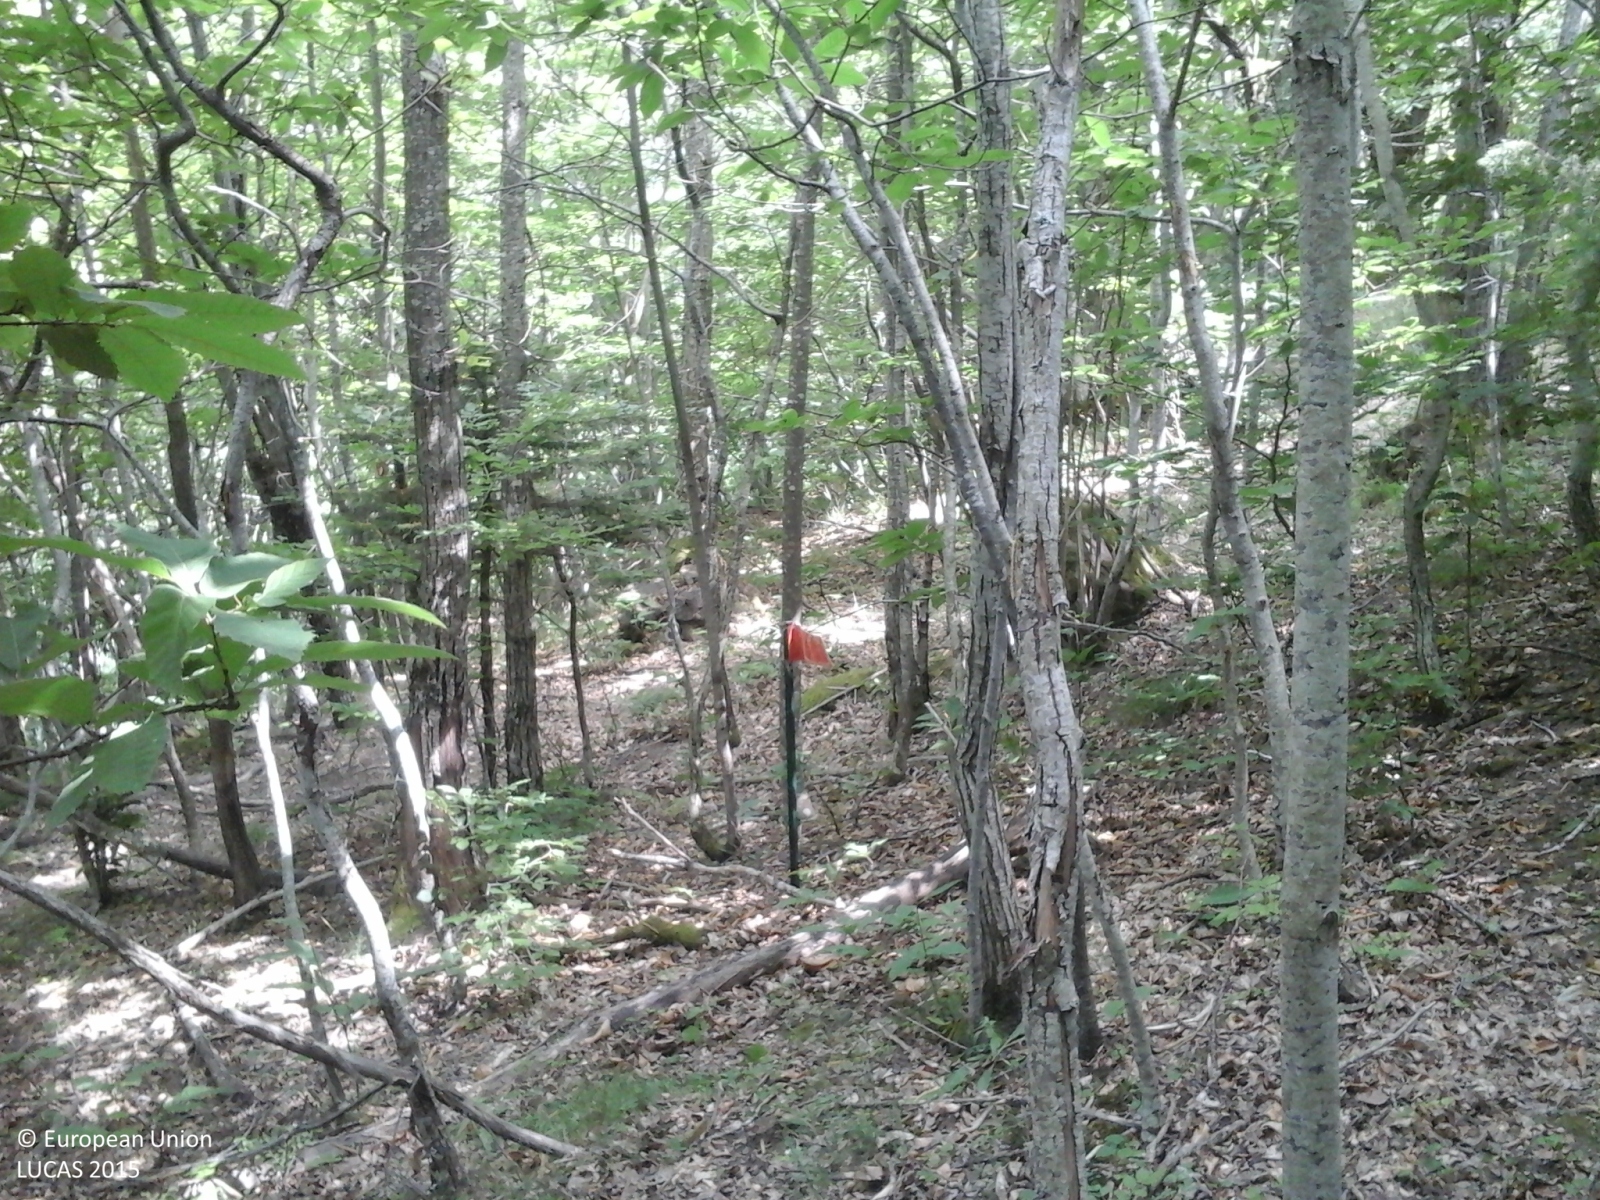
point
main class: Woodland
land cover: Broadleaved woodland
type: thermophilous deciduous forest
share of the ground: > 75 %
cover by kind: broadleaved forest trees 100 %
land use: Forestry
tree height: > 5 m
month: July
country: IT
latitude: 44.1864
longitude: 10.6115
